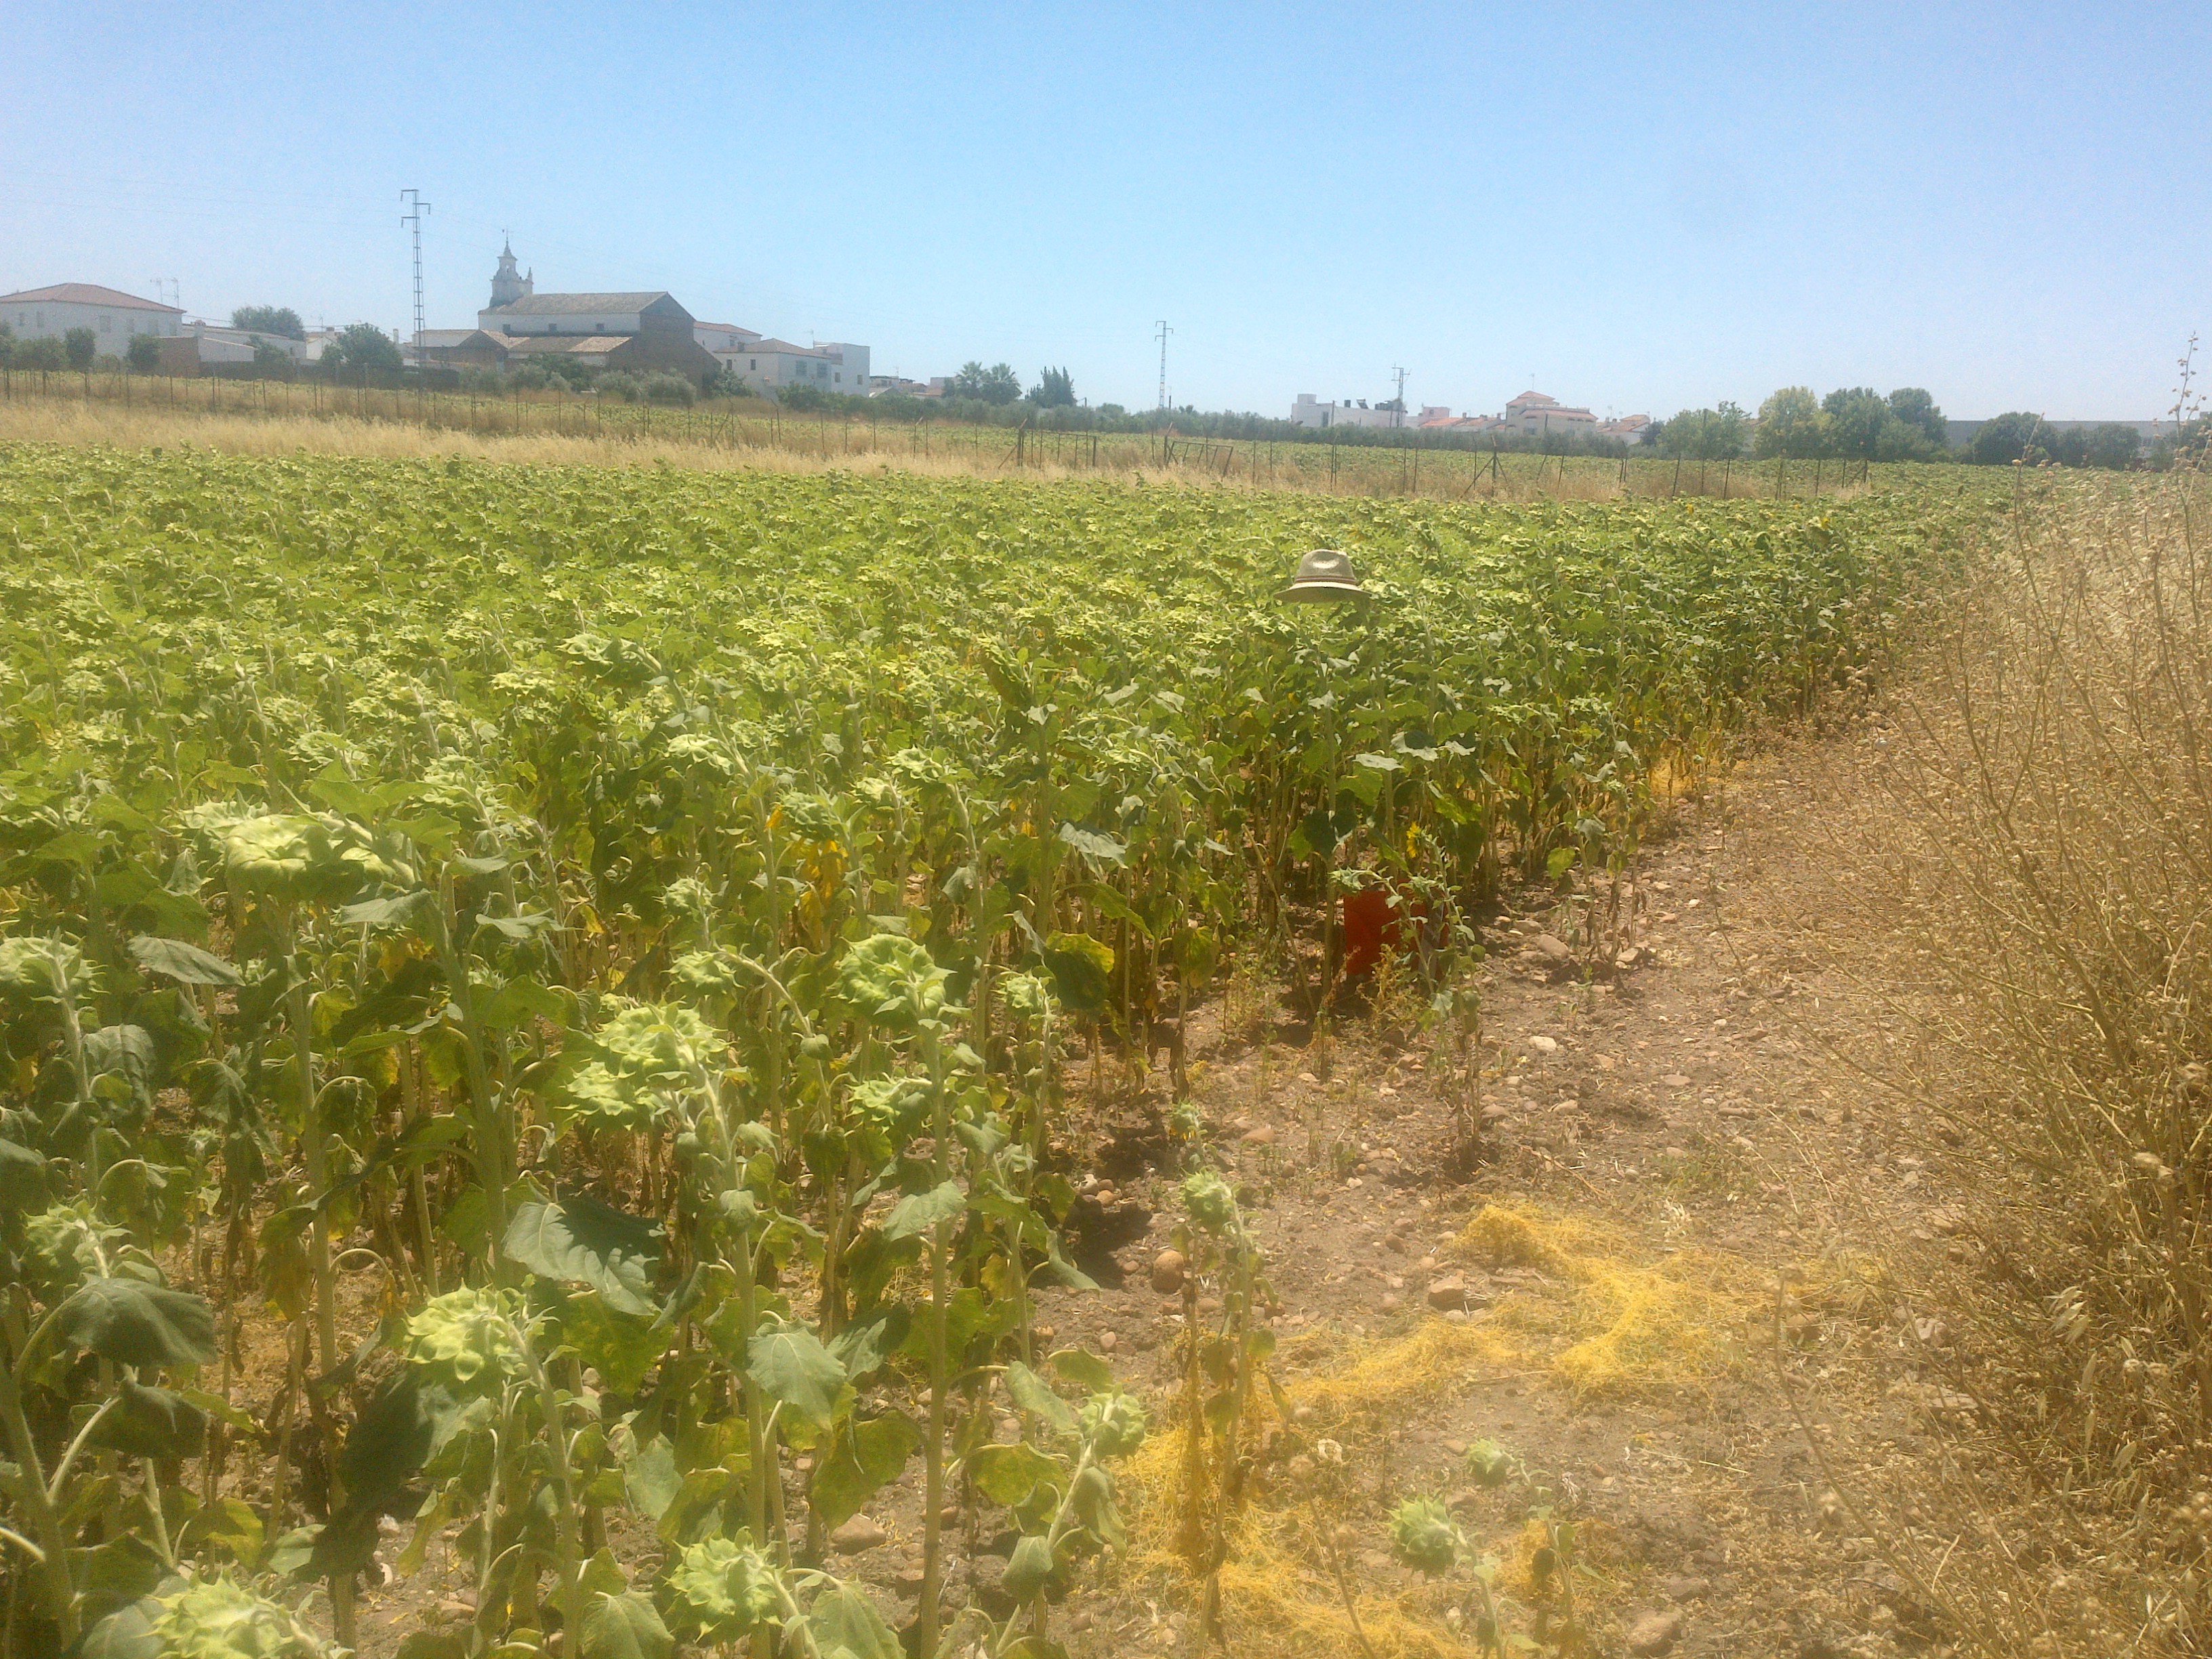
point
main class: Cropland
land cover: Sunflower
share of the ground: > 75 %
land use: Agriculture (excluding fallow land and kitchen gardens)
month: June
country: ES
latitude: 37.6387
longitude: -4.8684
